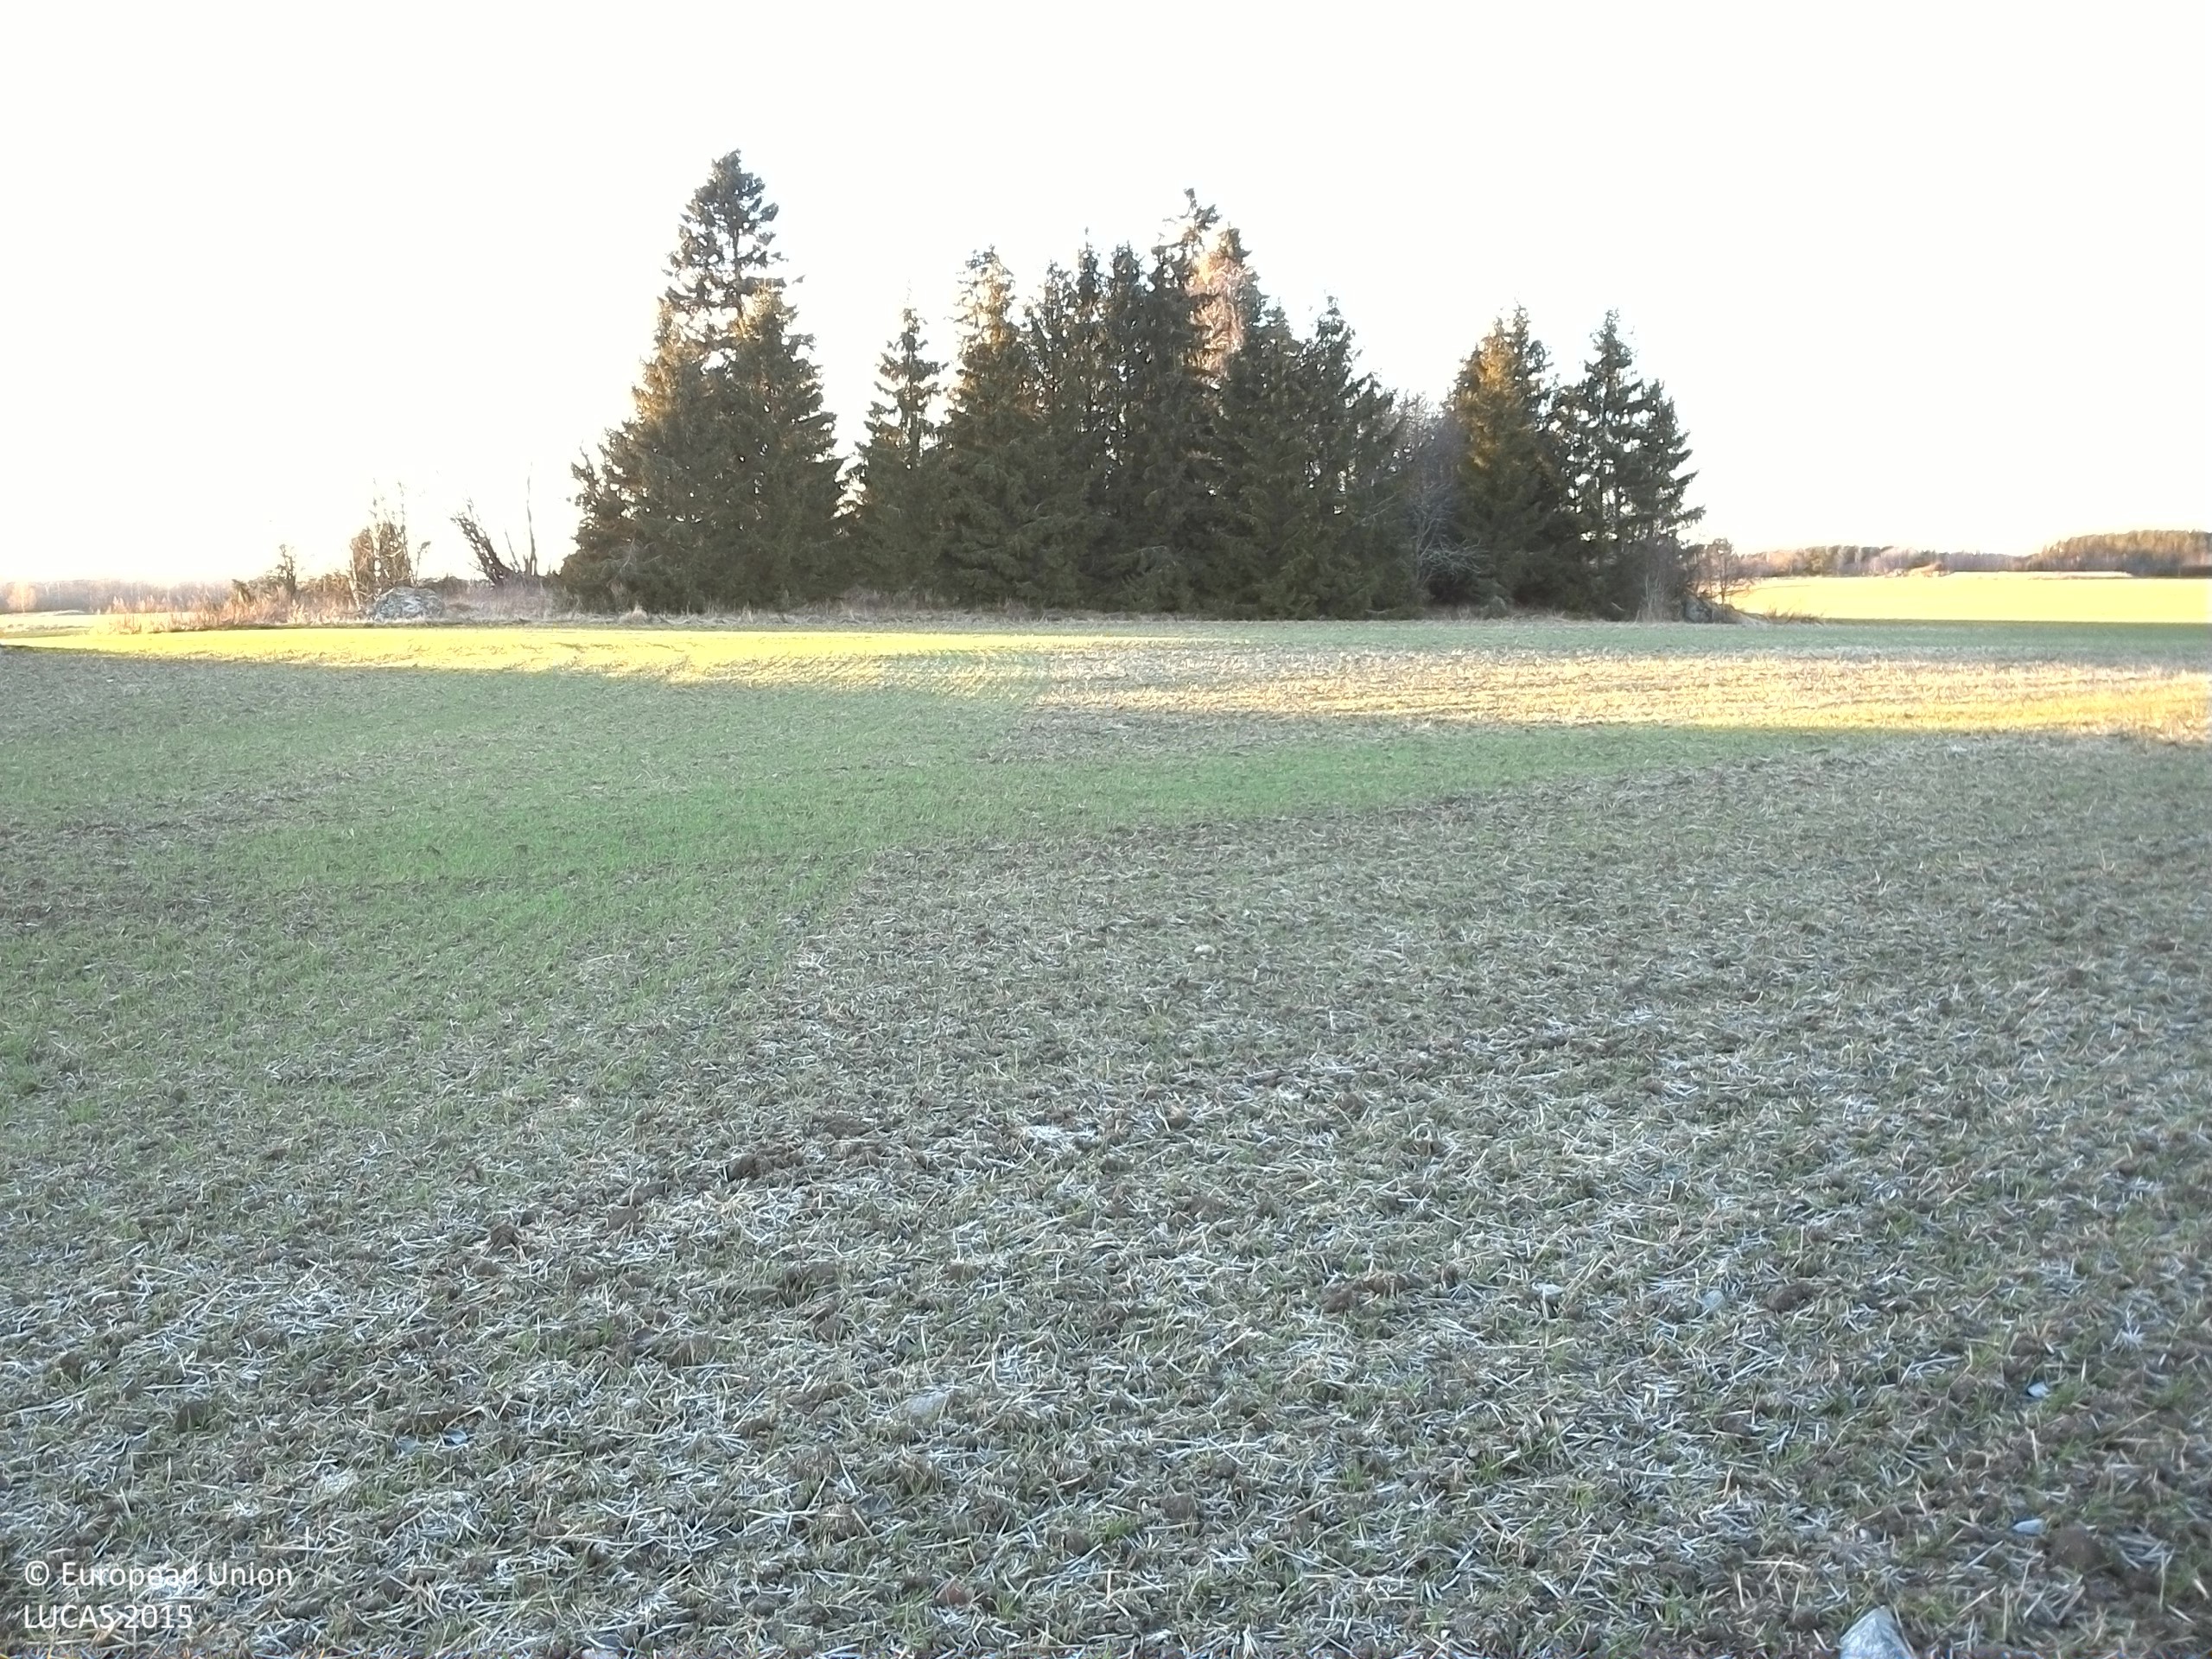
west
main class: Cropland
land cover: Common wheat
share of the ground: > 75 %
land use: Agriculture (excluding fallow land and kitchen gardens)
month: December
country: SE
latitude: 59.2882
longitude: 16.5412
